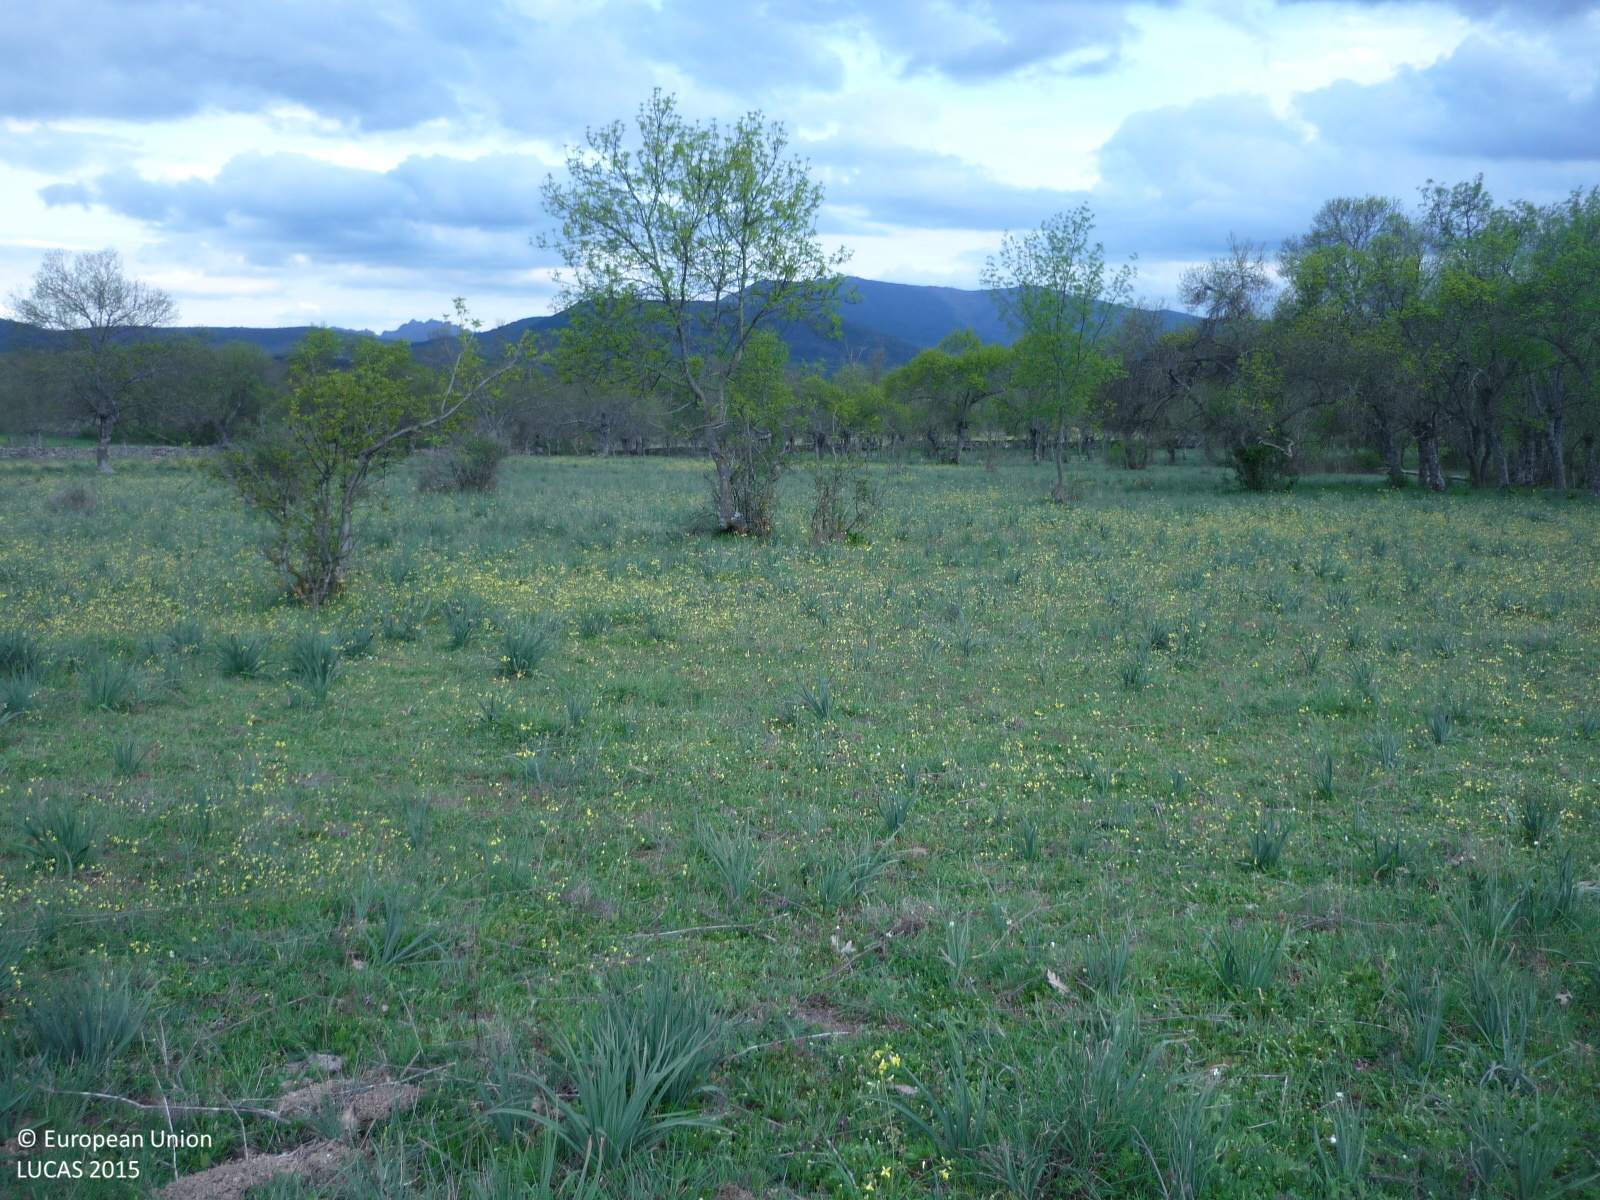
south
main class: Grassland
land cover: Grassland with sparse tree/shrub cover
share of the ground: > 75 %
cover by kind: herbaceous plants 85 %, shrubs 10 %, broadleaved forest trees 5 %
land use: Agriculture (excluding fallow land and kitchen gardens)
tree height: < 5 m
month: April
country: ES
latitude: 40.9892
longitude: -3.6783
